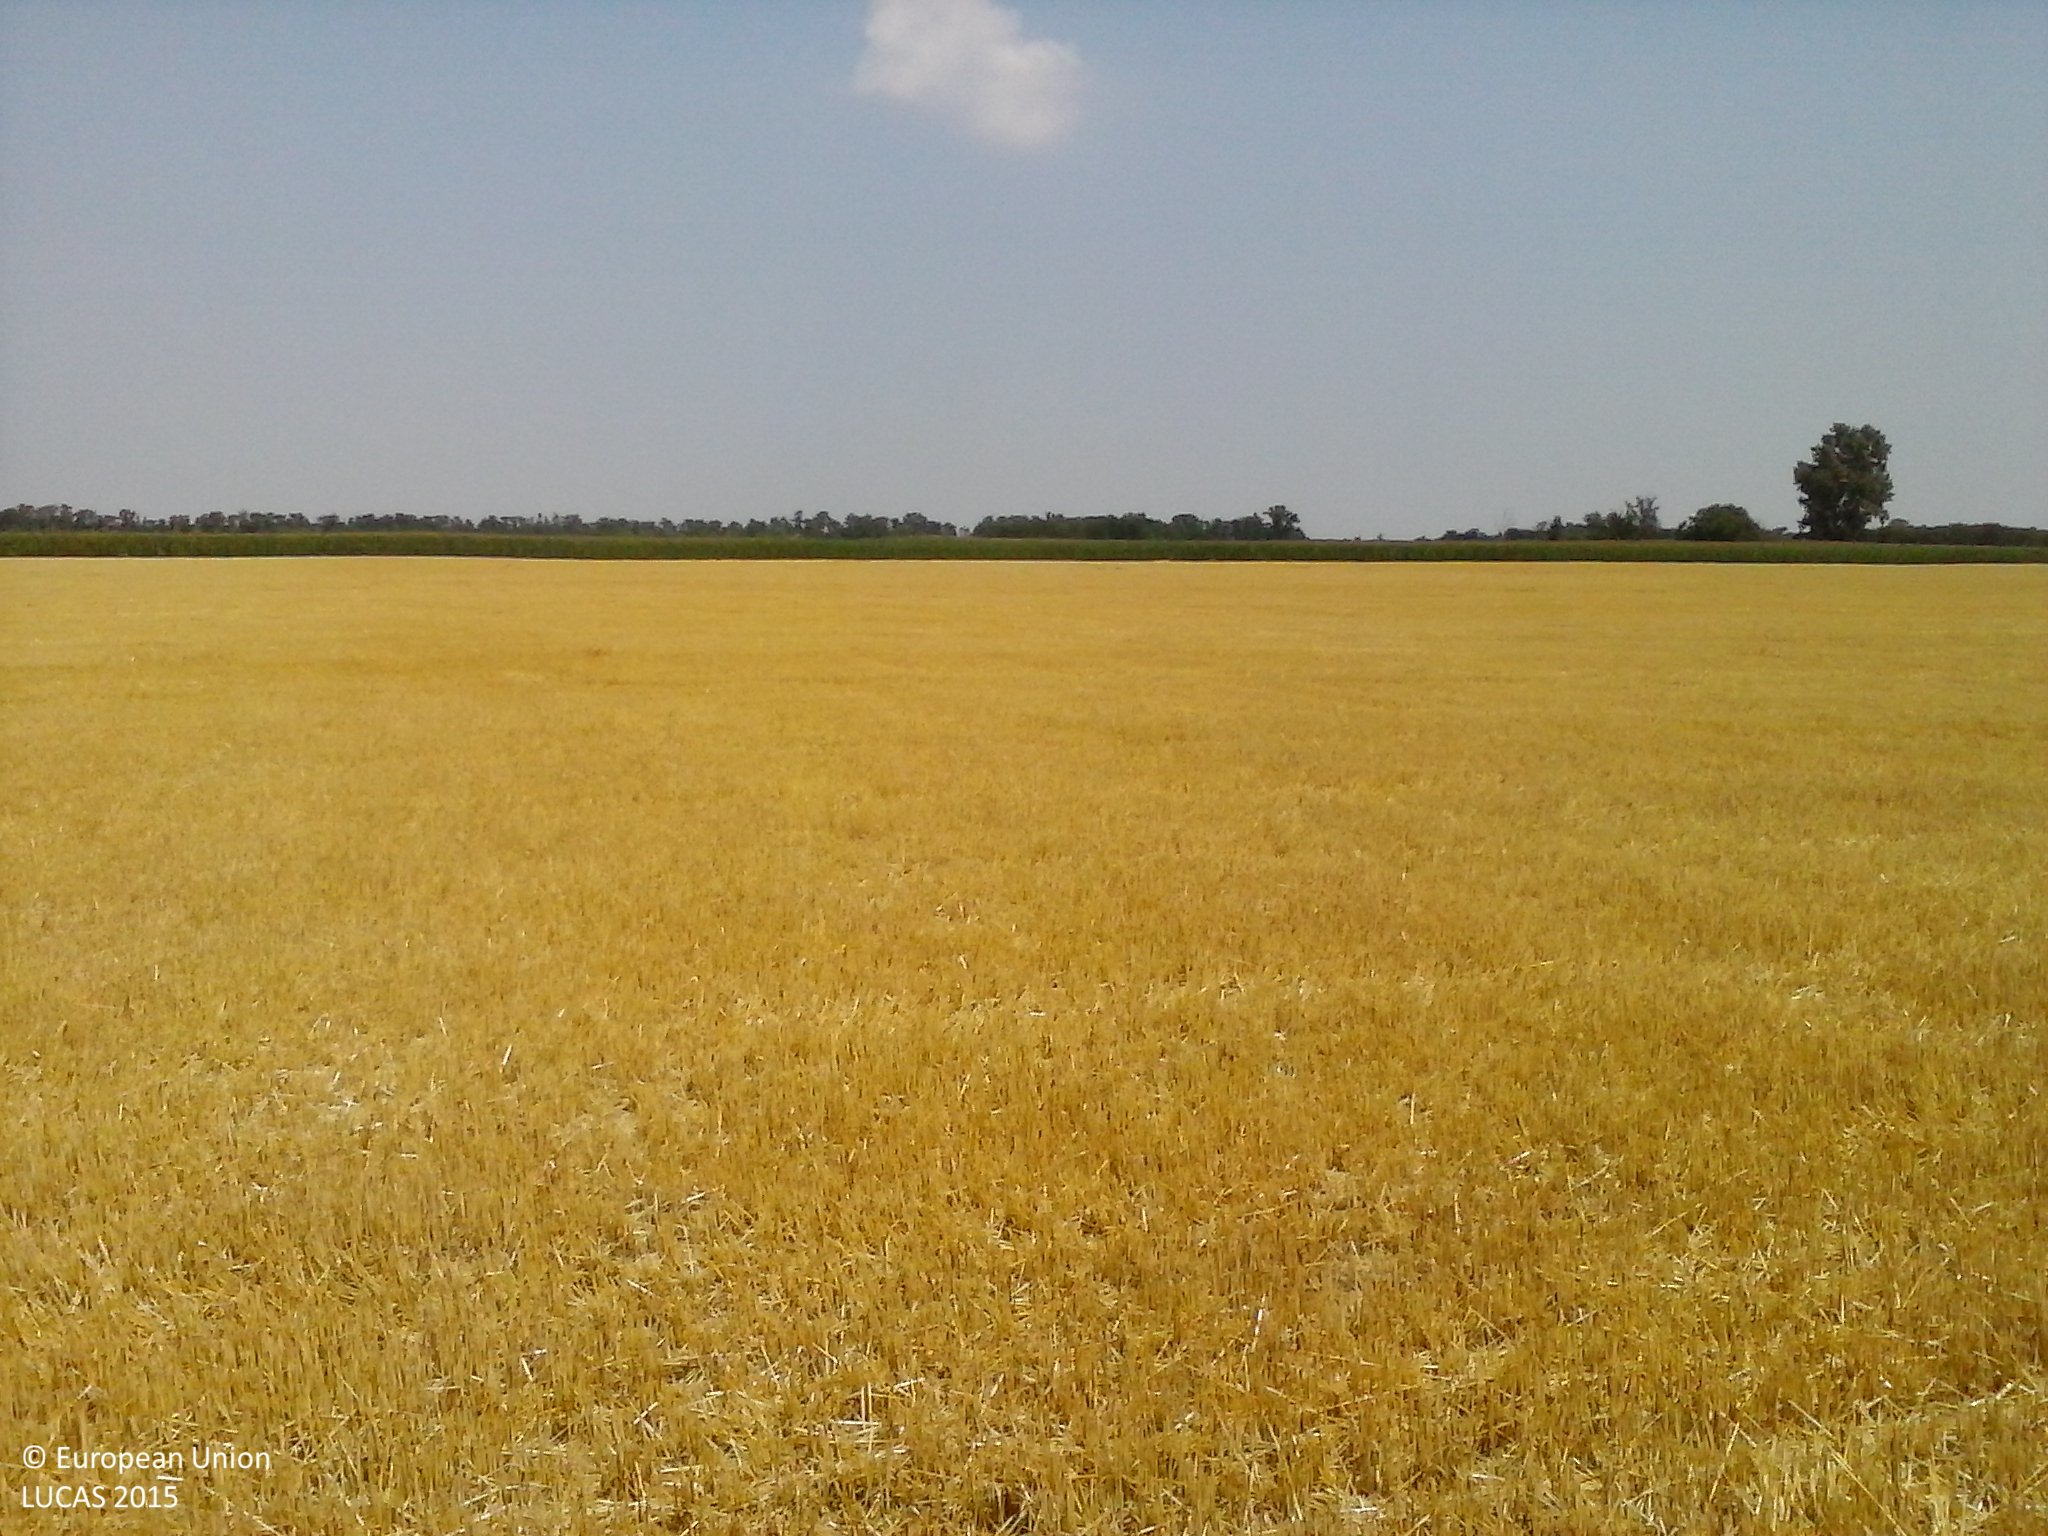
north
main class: Cropland
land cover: Common wheat
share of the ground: 50 - 75 %
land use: Agriculture (excluding fallow land and kitchen gardens)
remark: Harvested field
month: February
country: HU
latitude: 46.5183
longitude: 20.5460
